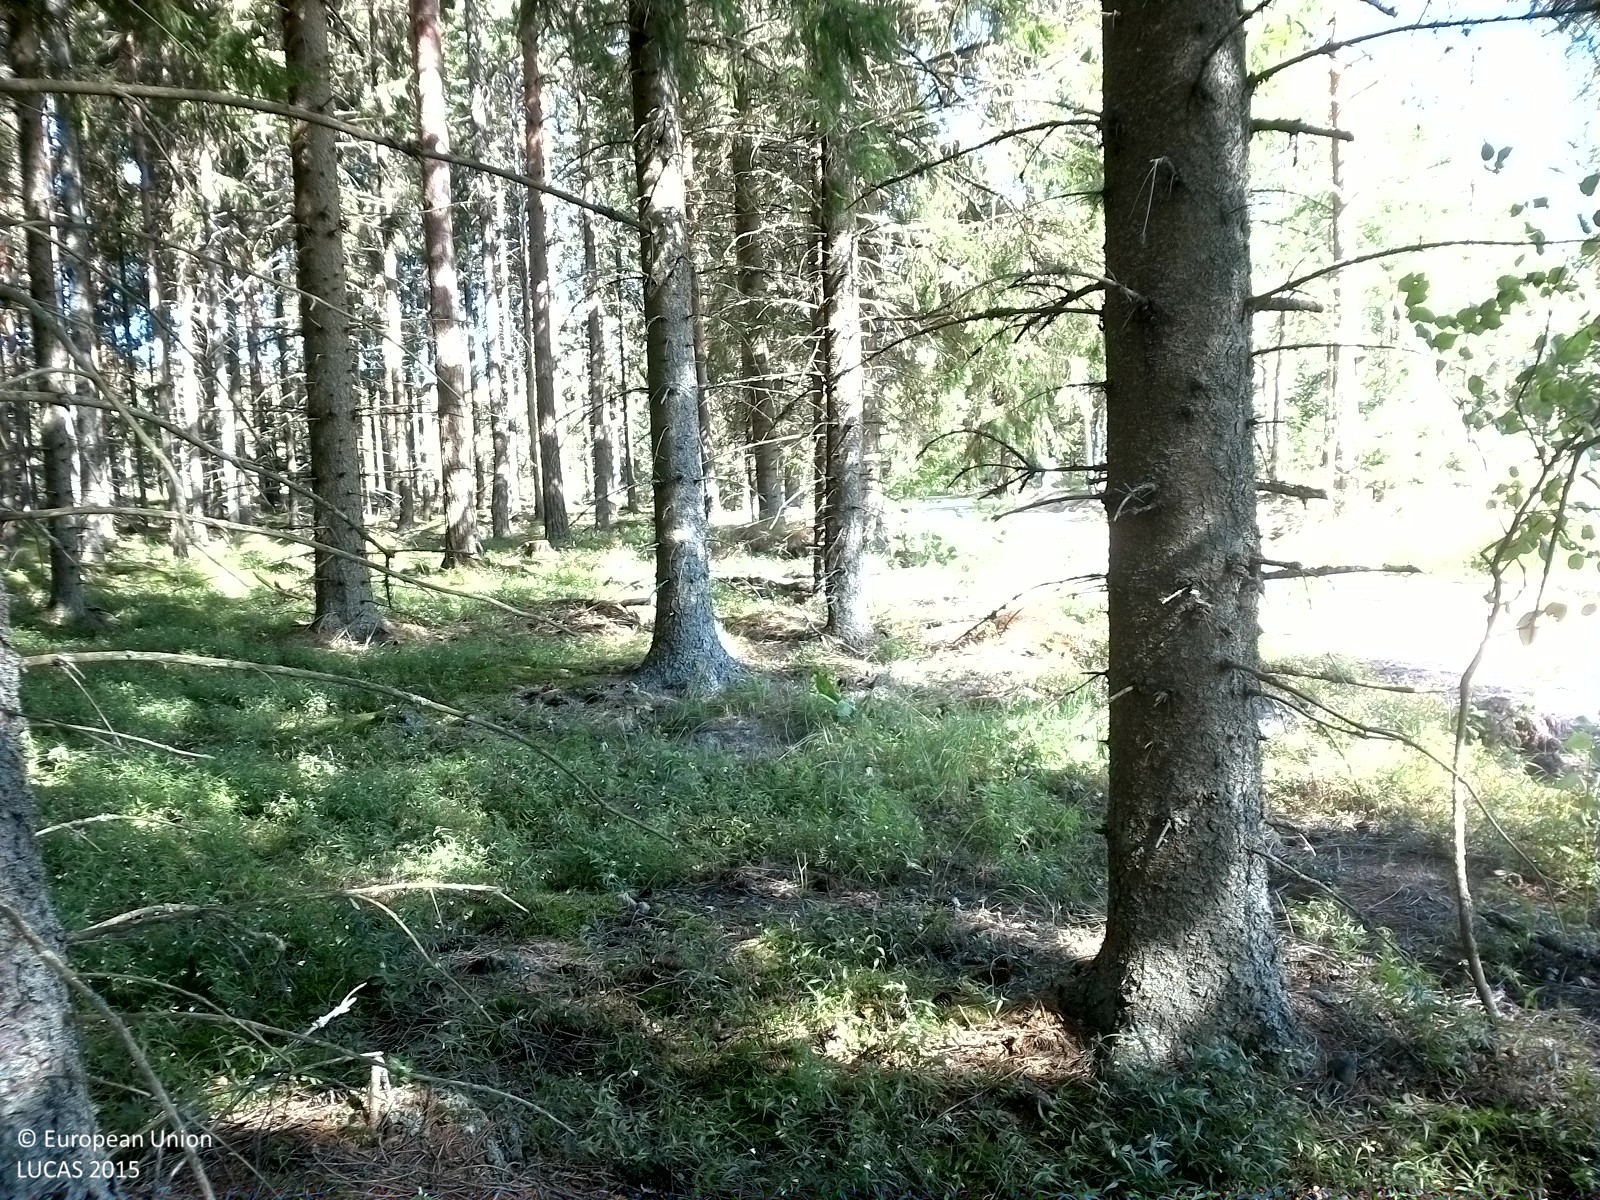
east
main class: Woodland
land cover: Spruce dominated coniferous woodland
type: boreal forest
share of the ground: 50 - 75 %
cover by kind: coniferous forest trees 55 %, lichens and mosses 25 %, herbaceous plants 20 %
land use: Forestry
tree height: > 5 m
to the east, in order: Spruce dominated coniferous woodland; Ditches and canals; Paved roads, cycling and walking lanes; Ditches and canals; Spruce dominated mixed woodland; Broadleaved woodland; Other mixed woodland
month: August
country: SE
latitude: 59.4203
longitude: 15.1194
